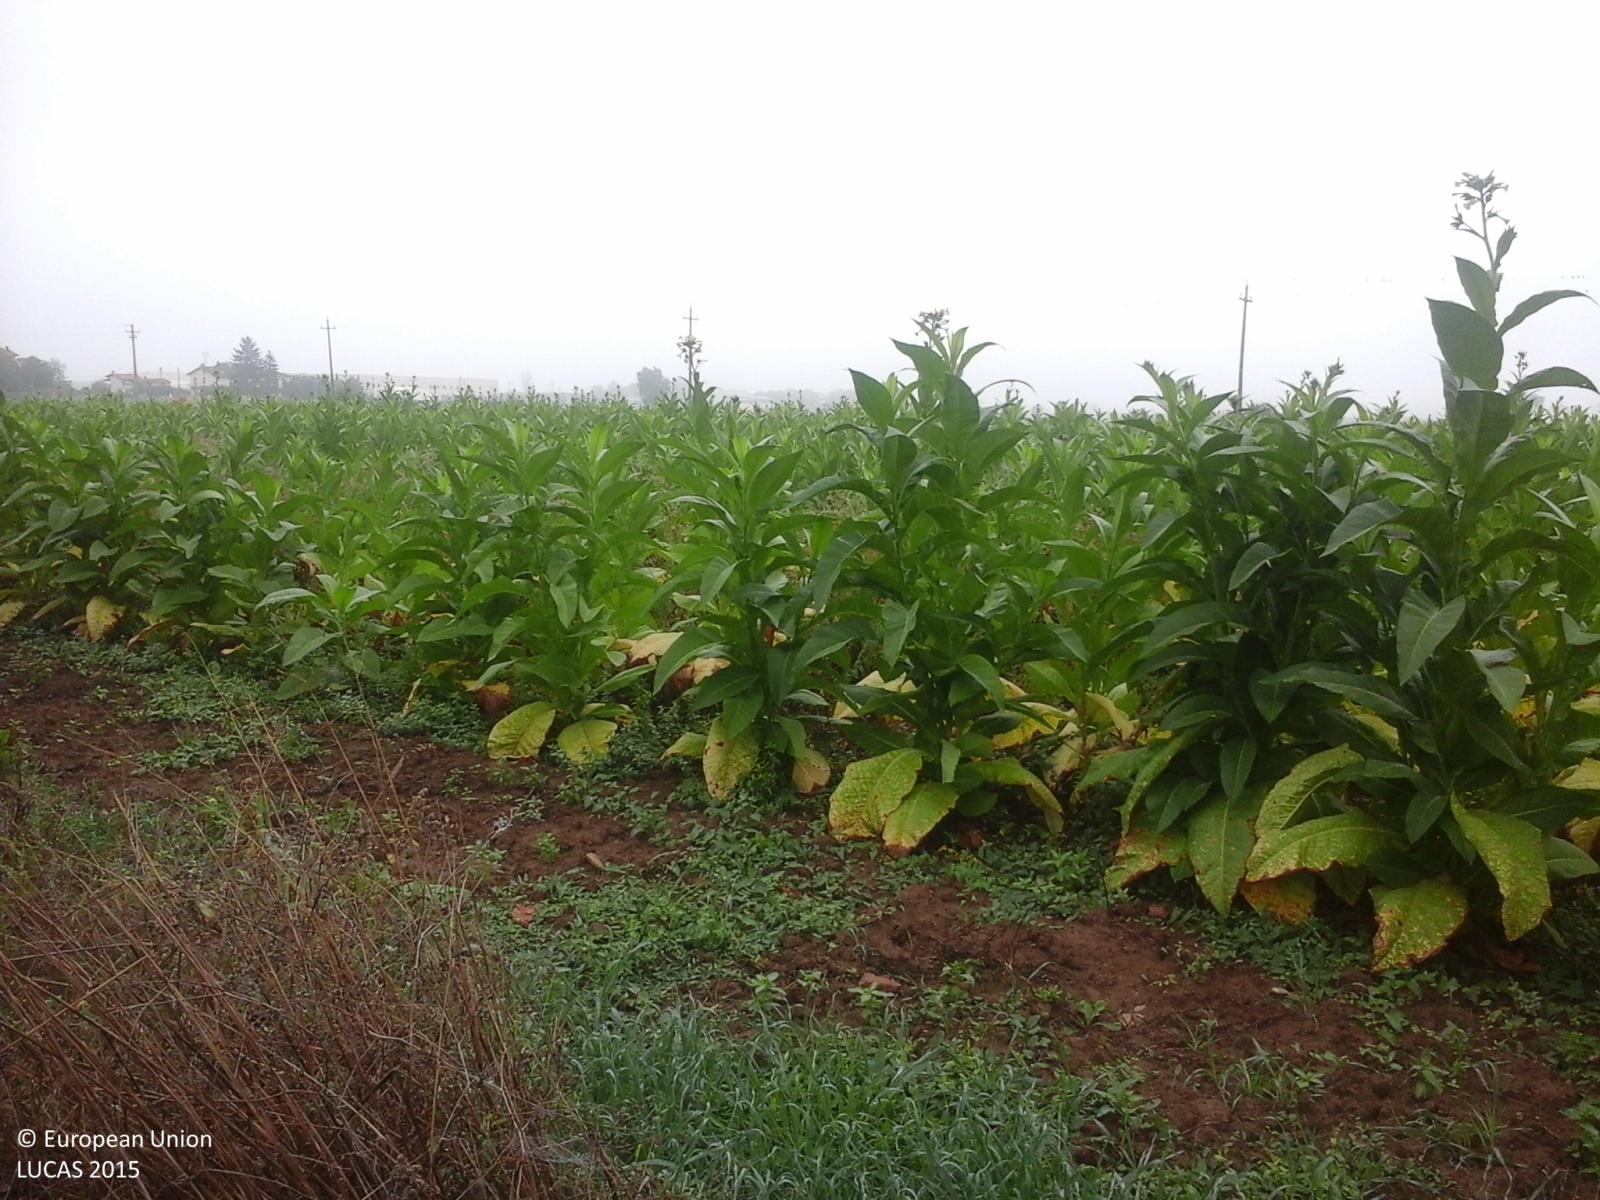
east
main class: Cropland
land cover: Tobacco
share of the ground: > 75 %
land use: Agriculture (excluding fallow land and kitchen gardens)
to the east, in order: Tobacco; Ditches and canals; Common wheat; Electric lines; Common wheat; Ditches and canals; Tobacco; Clovers; Tracks; Ditches and canals; Common wheat
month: October
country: IT
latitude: 43.5170
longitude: 12.1098
